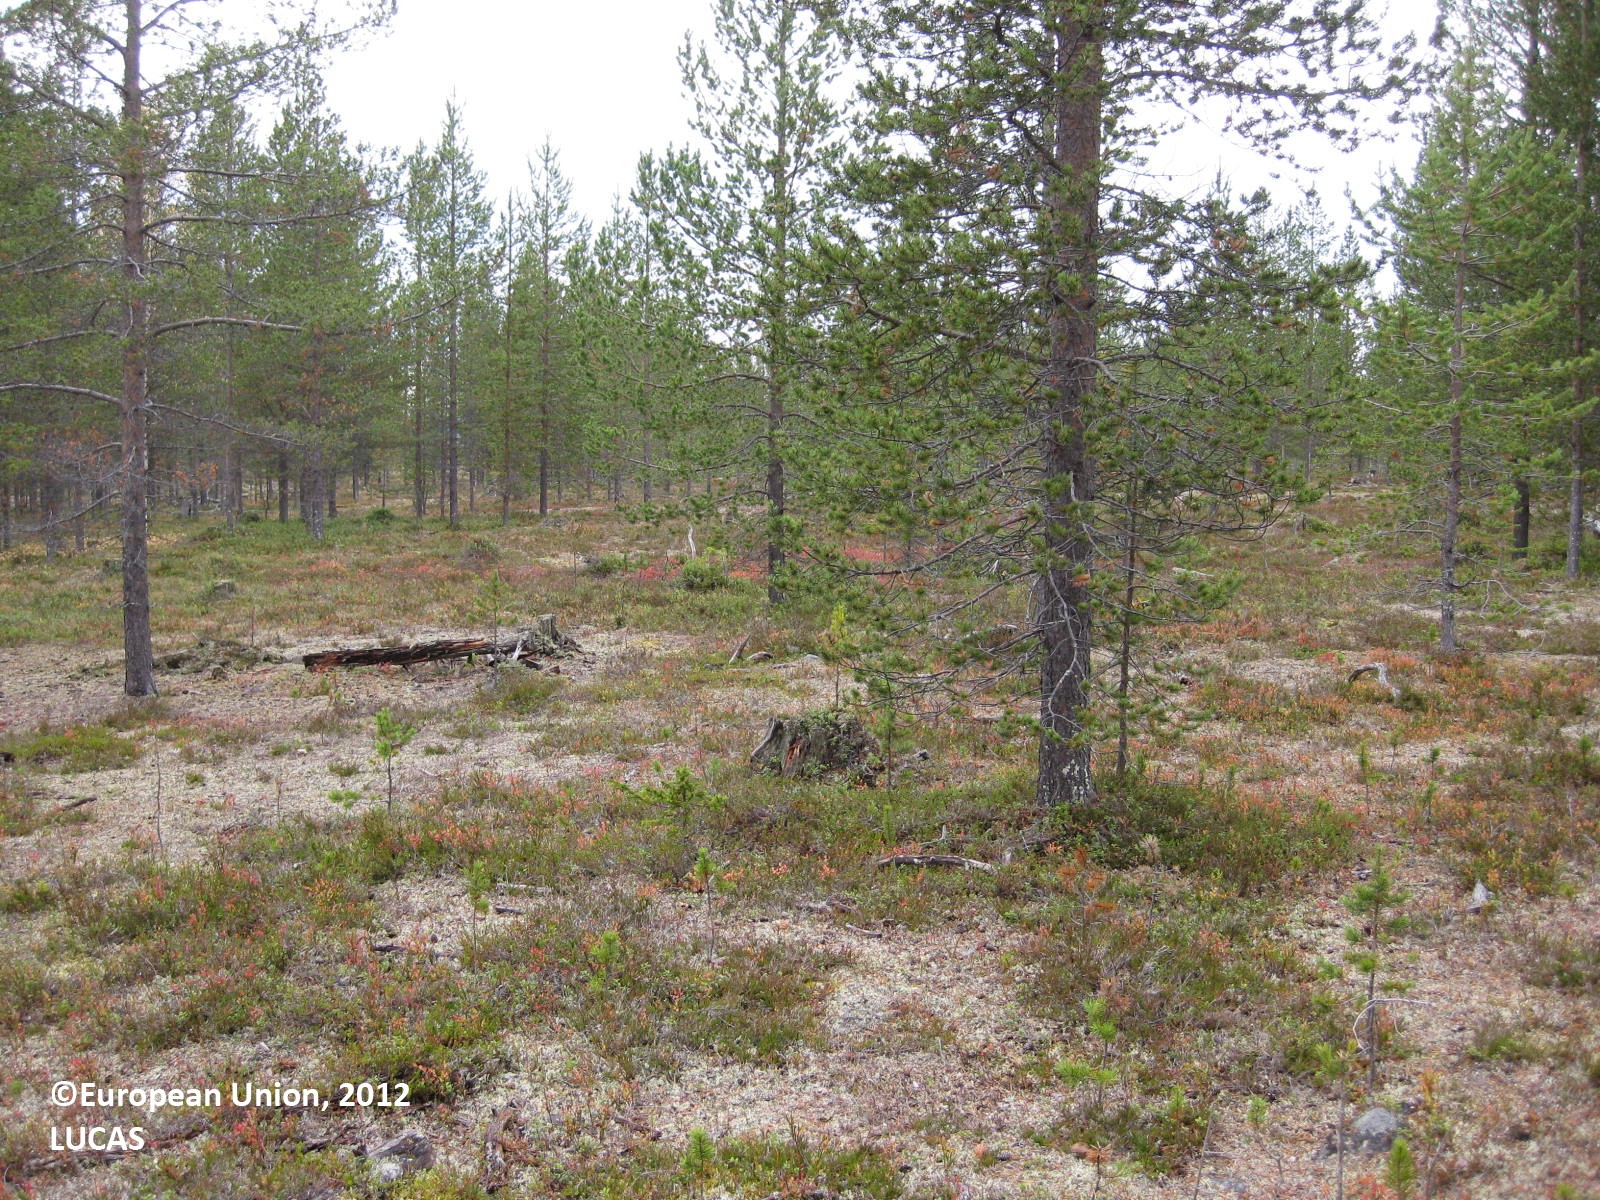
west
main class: Woodland
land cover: Pine dominated coniferous woodland
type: boreal forest
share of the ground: 50 - 75 %
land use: Forestry
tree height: > 5 m
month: September
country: FI
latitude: 68.0933
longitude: 23.7247
